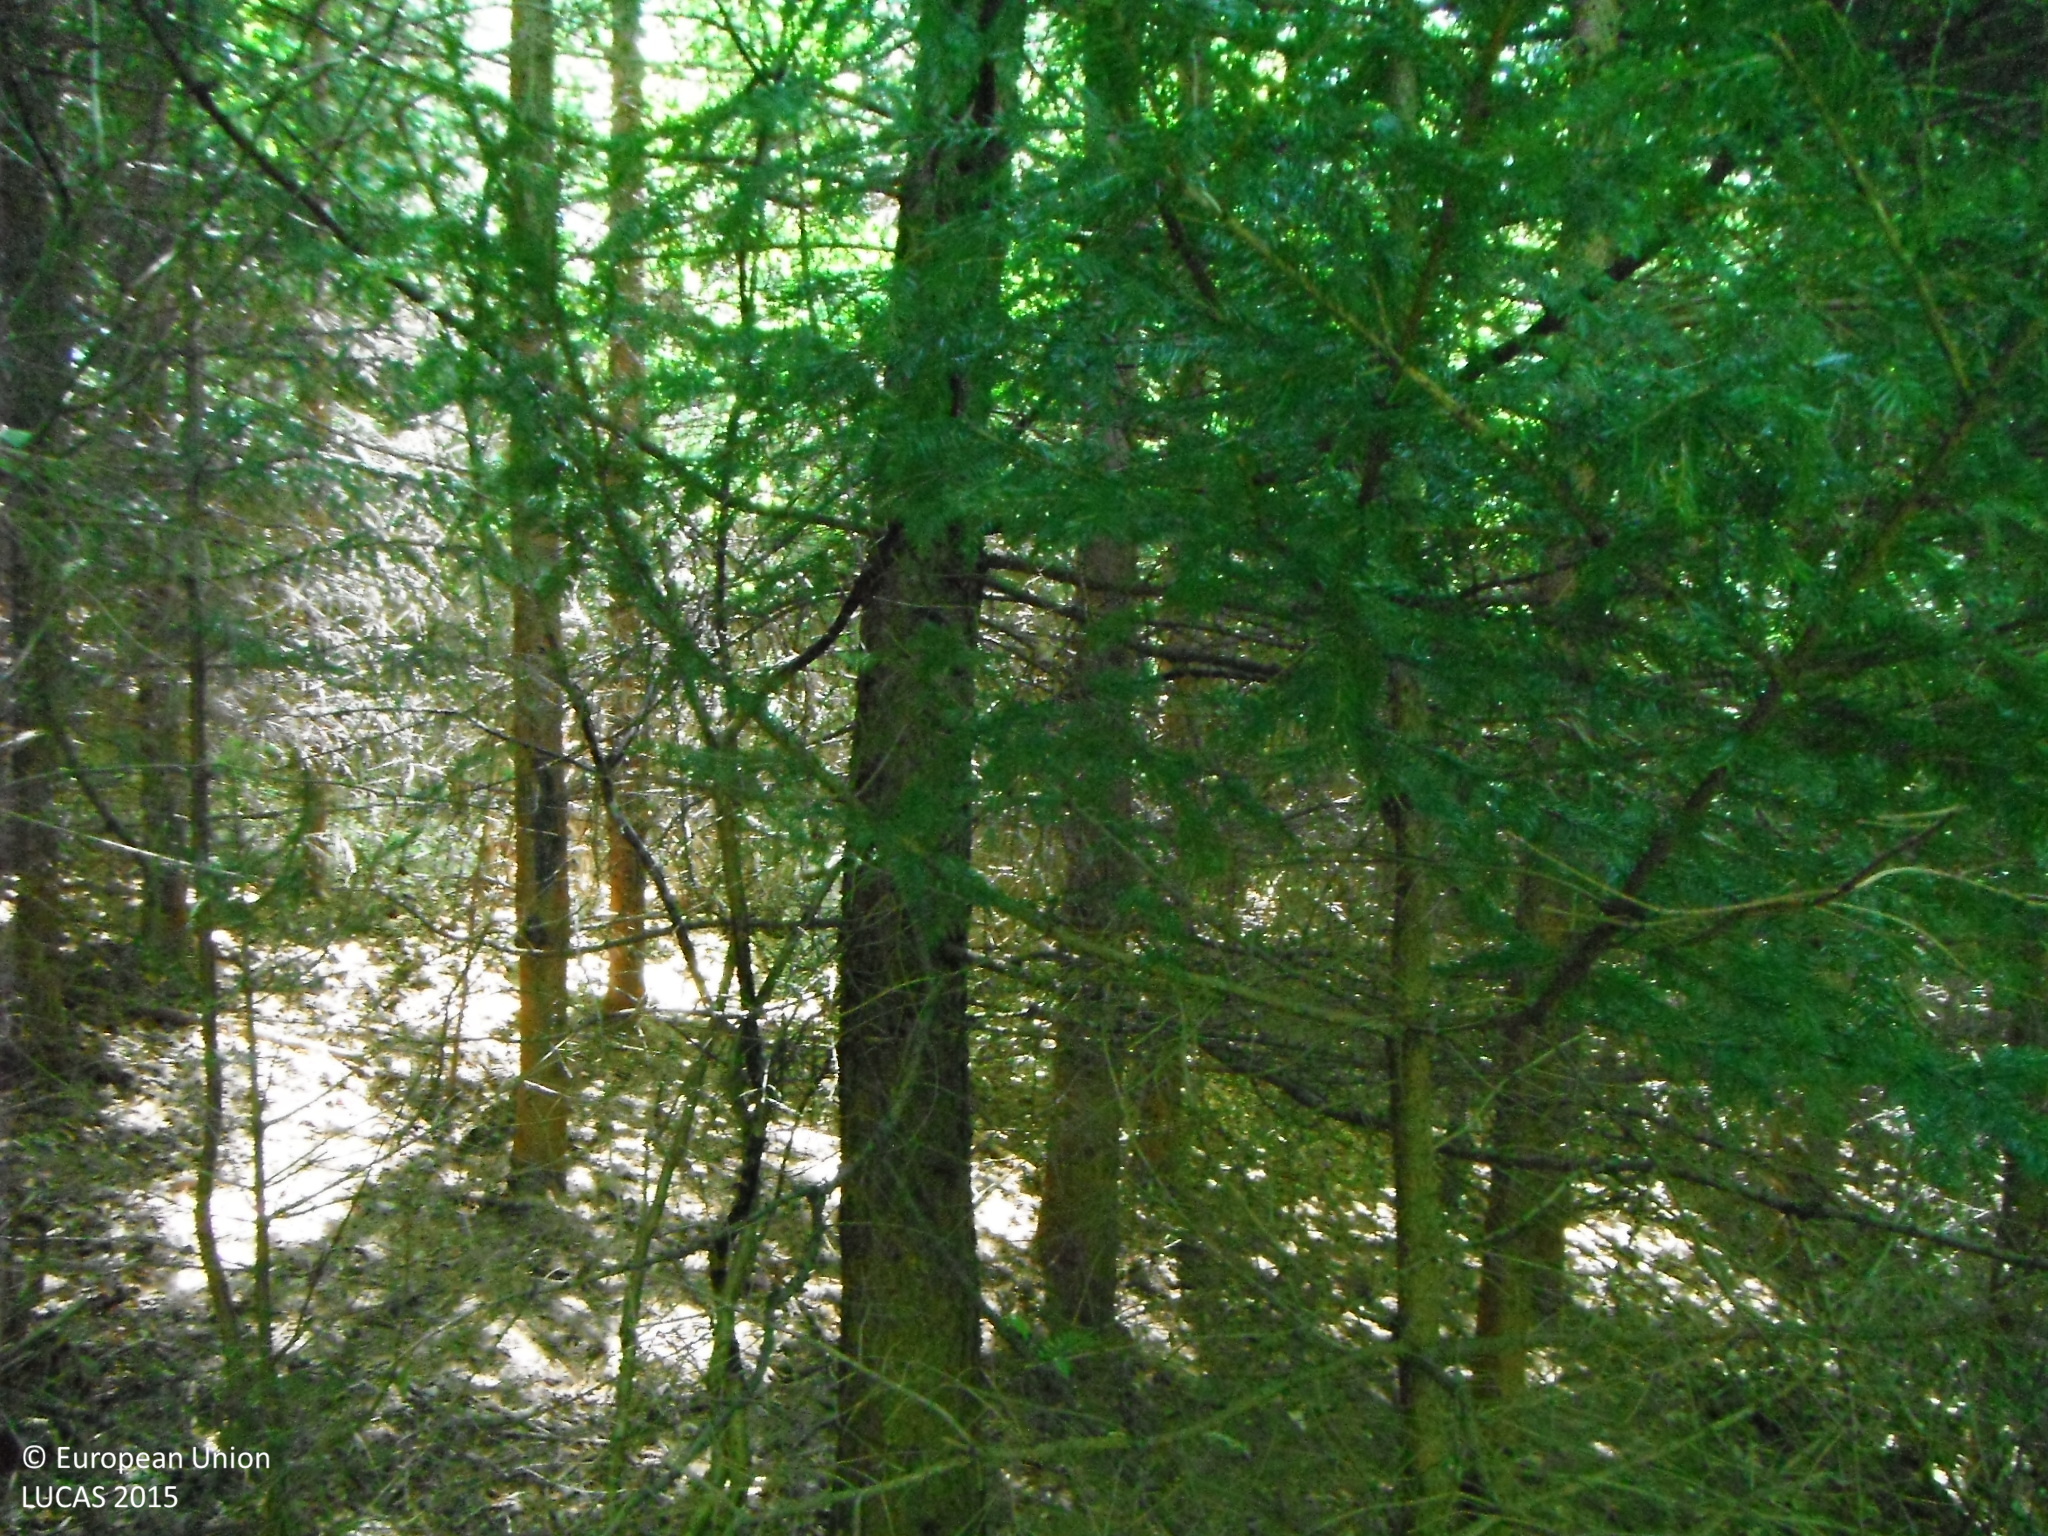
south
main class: Woodland
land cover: Spruce dominated coniferous woodland
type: alpine coniferous forest
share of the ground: > 75 %
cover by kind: coniferous forest trees 100 %
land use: Forestry
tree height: > 5 m
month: June
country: SK
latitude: 49.1222
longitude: 19.2180
